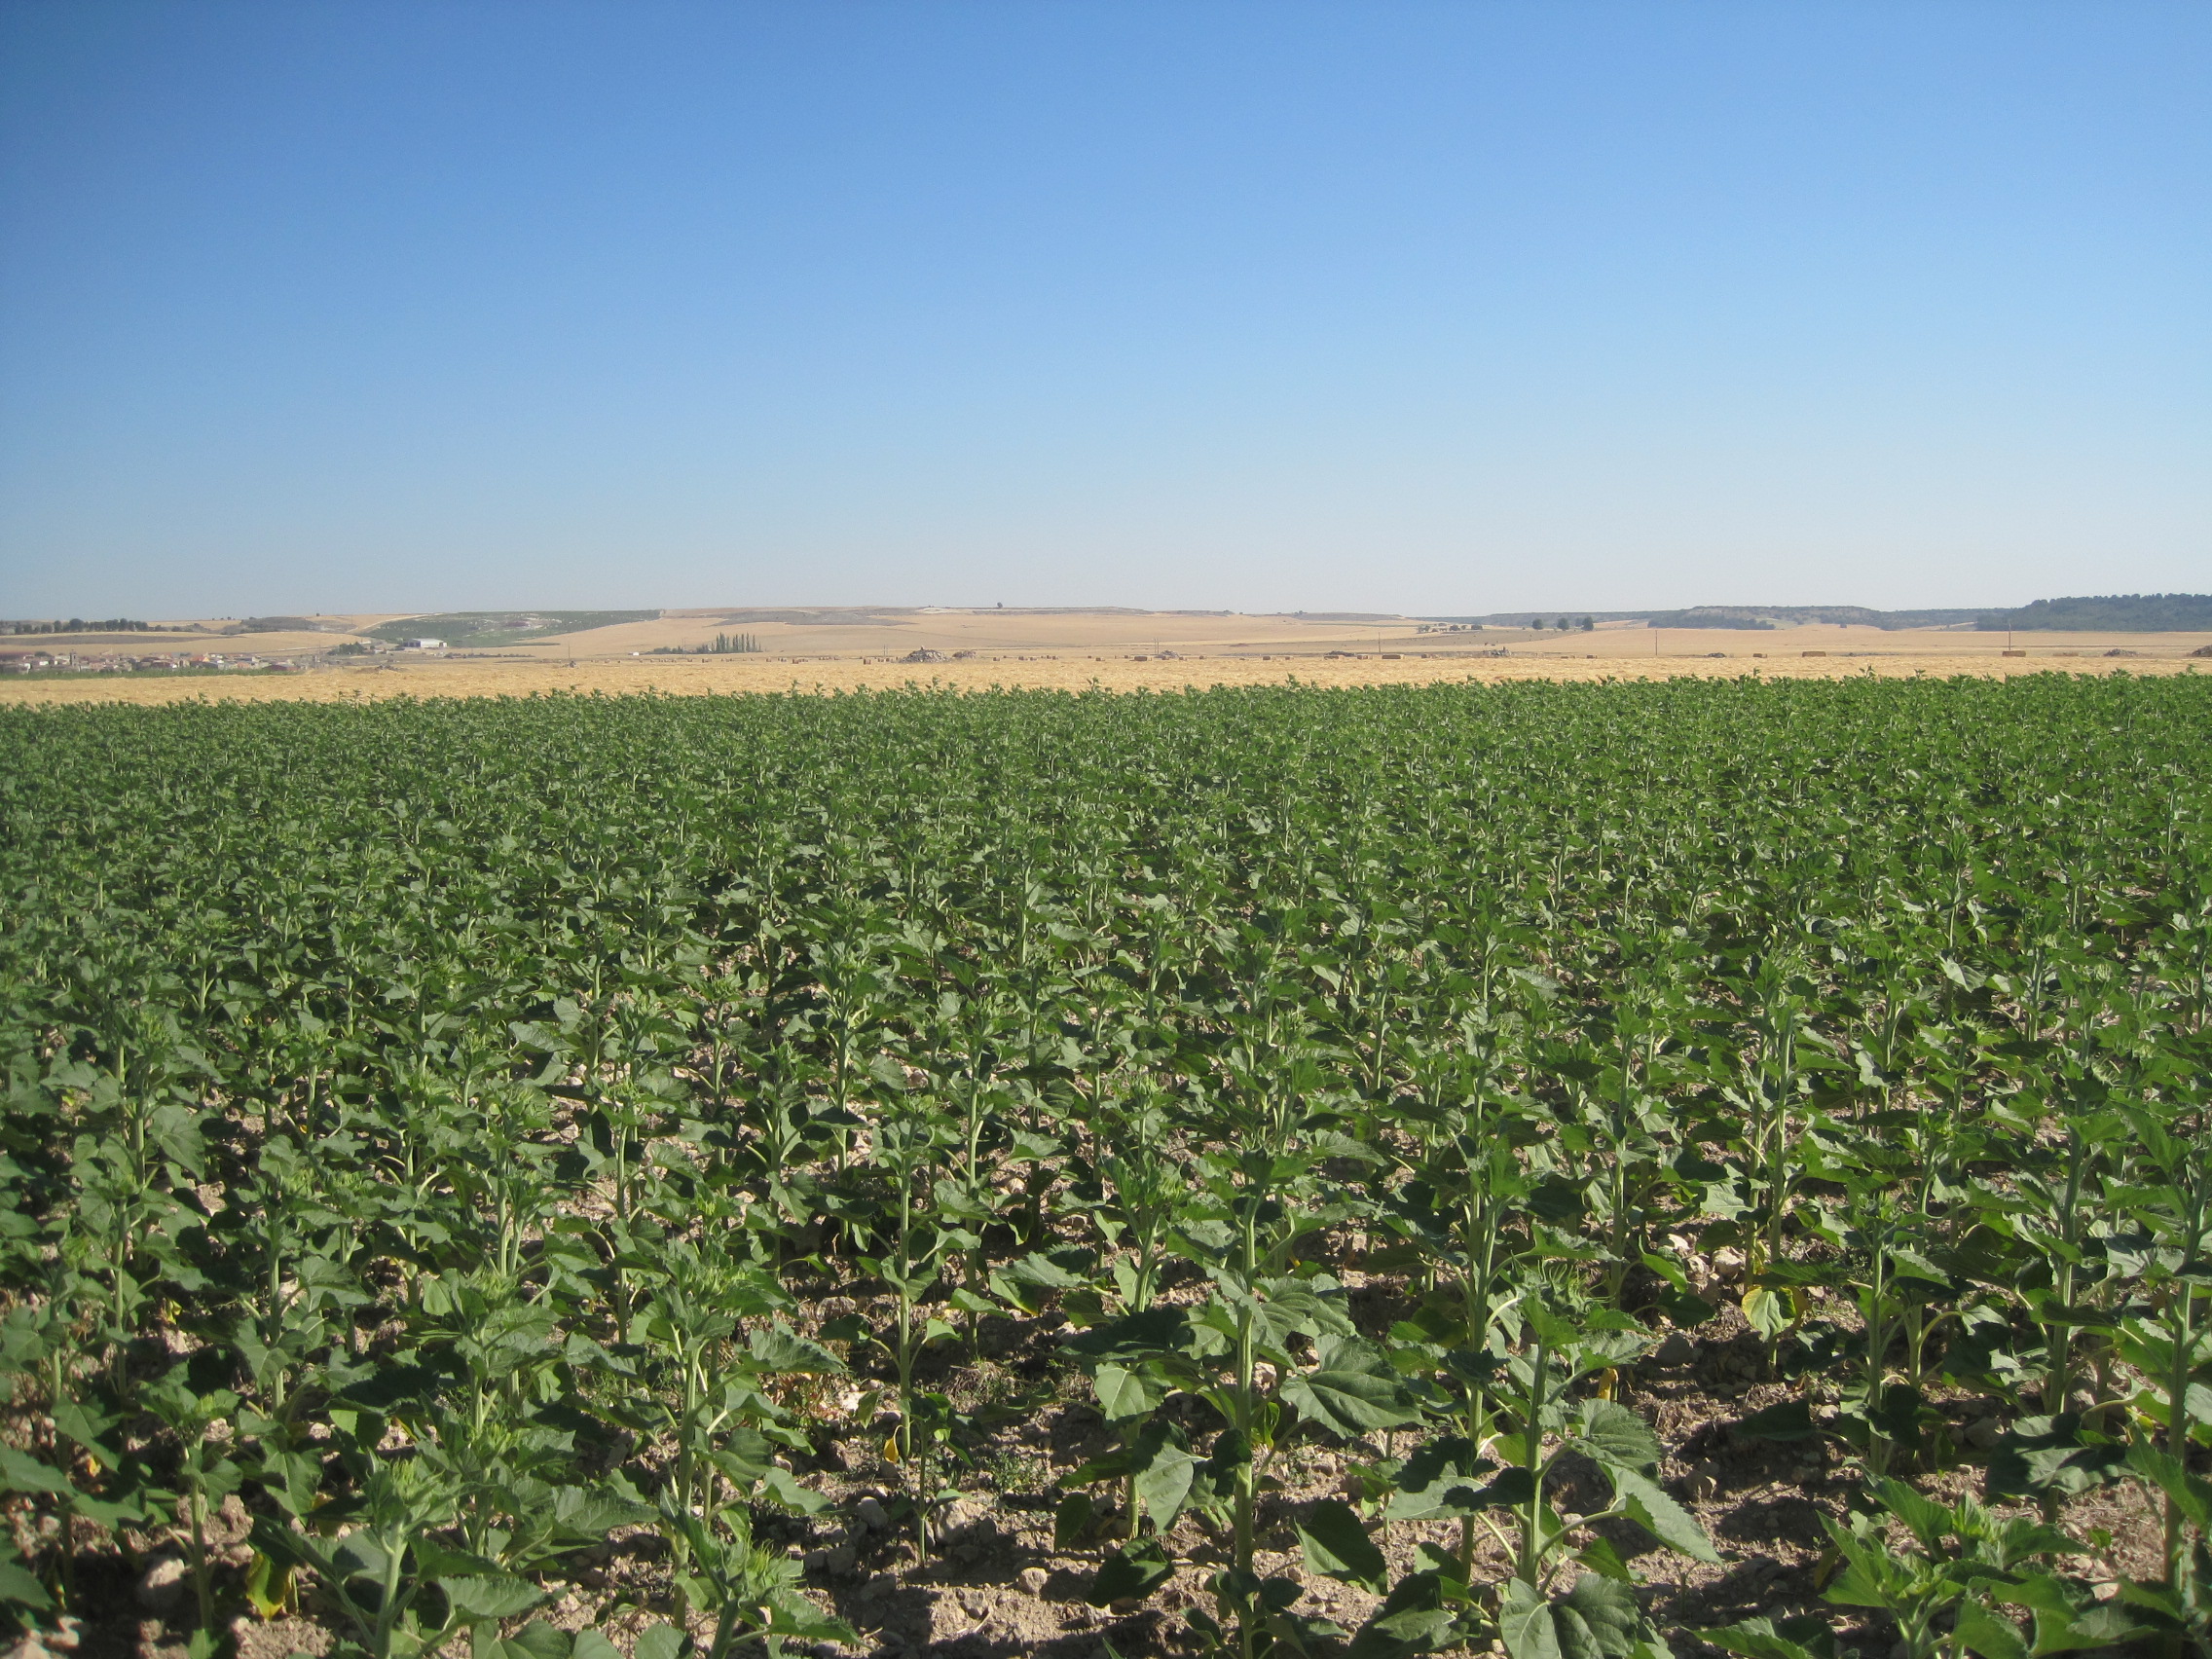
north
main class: Cropland
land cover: Sunflower
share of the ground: > 75 %
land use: Agriculture (excluding fallow land and kitchen gardens)
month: July
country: ES
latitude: 41.8383
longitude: -4.6535
